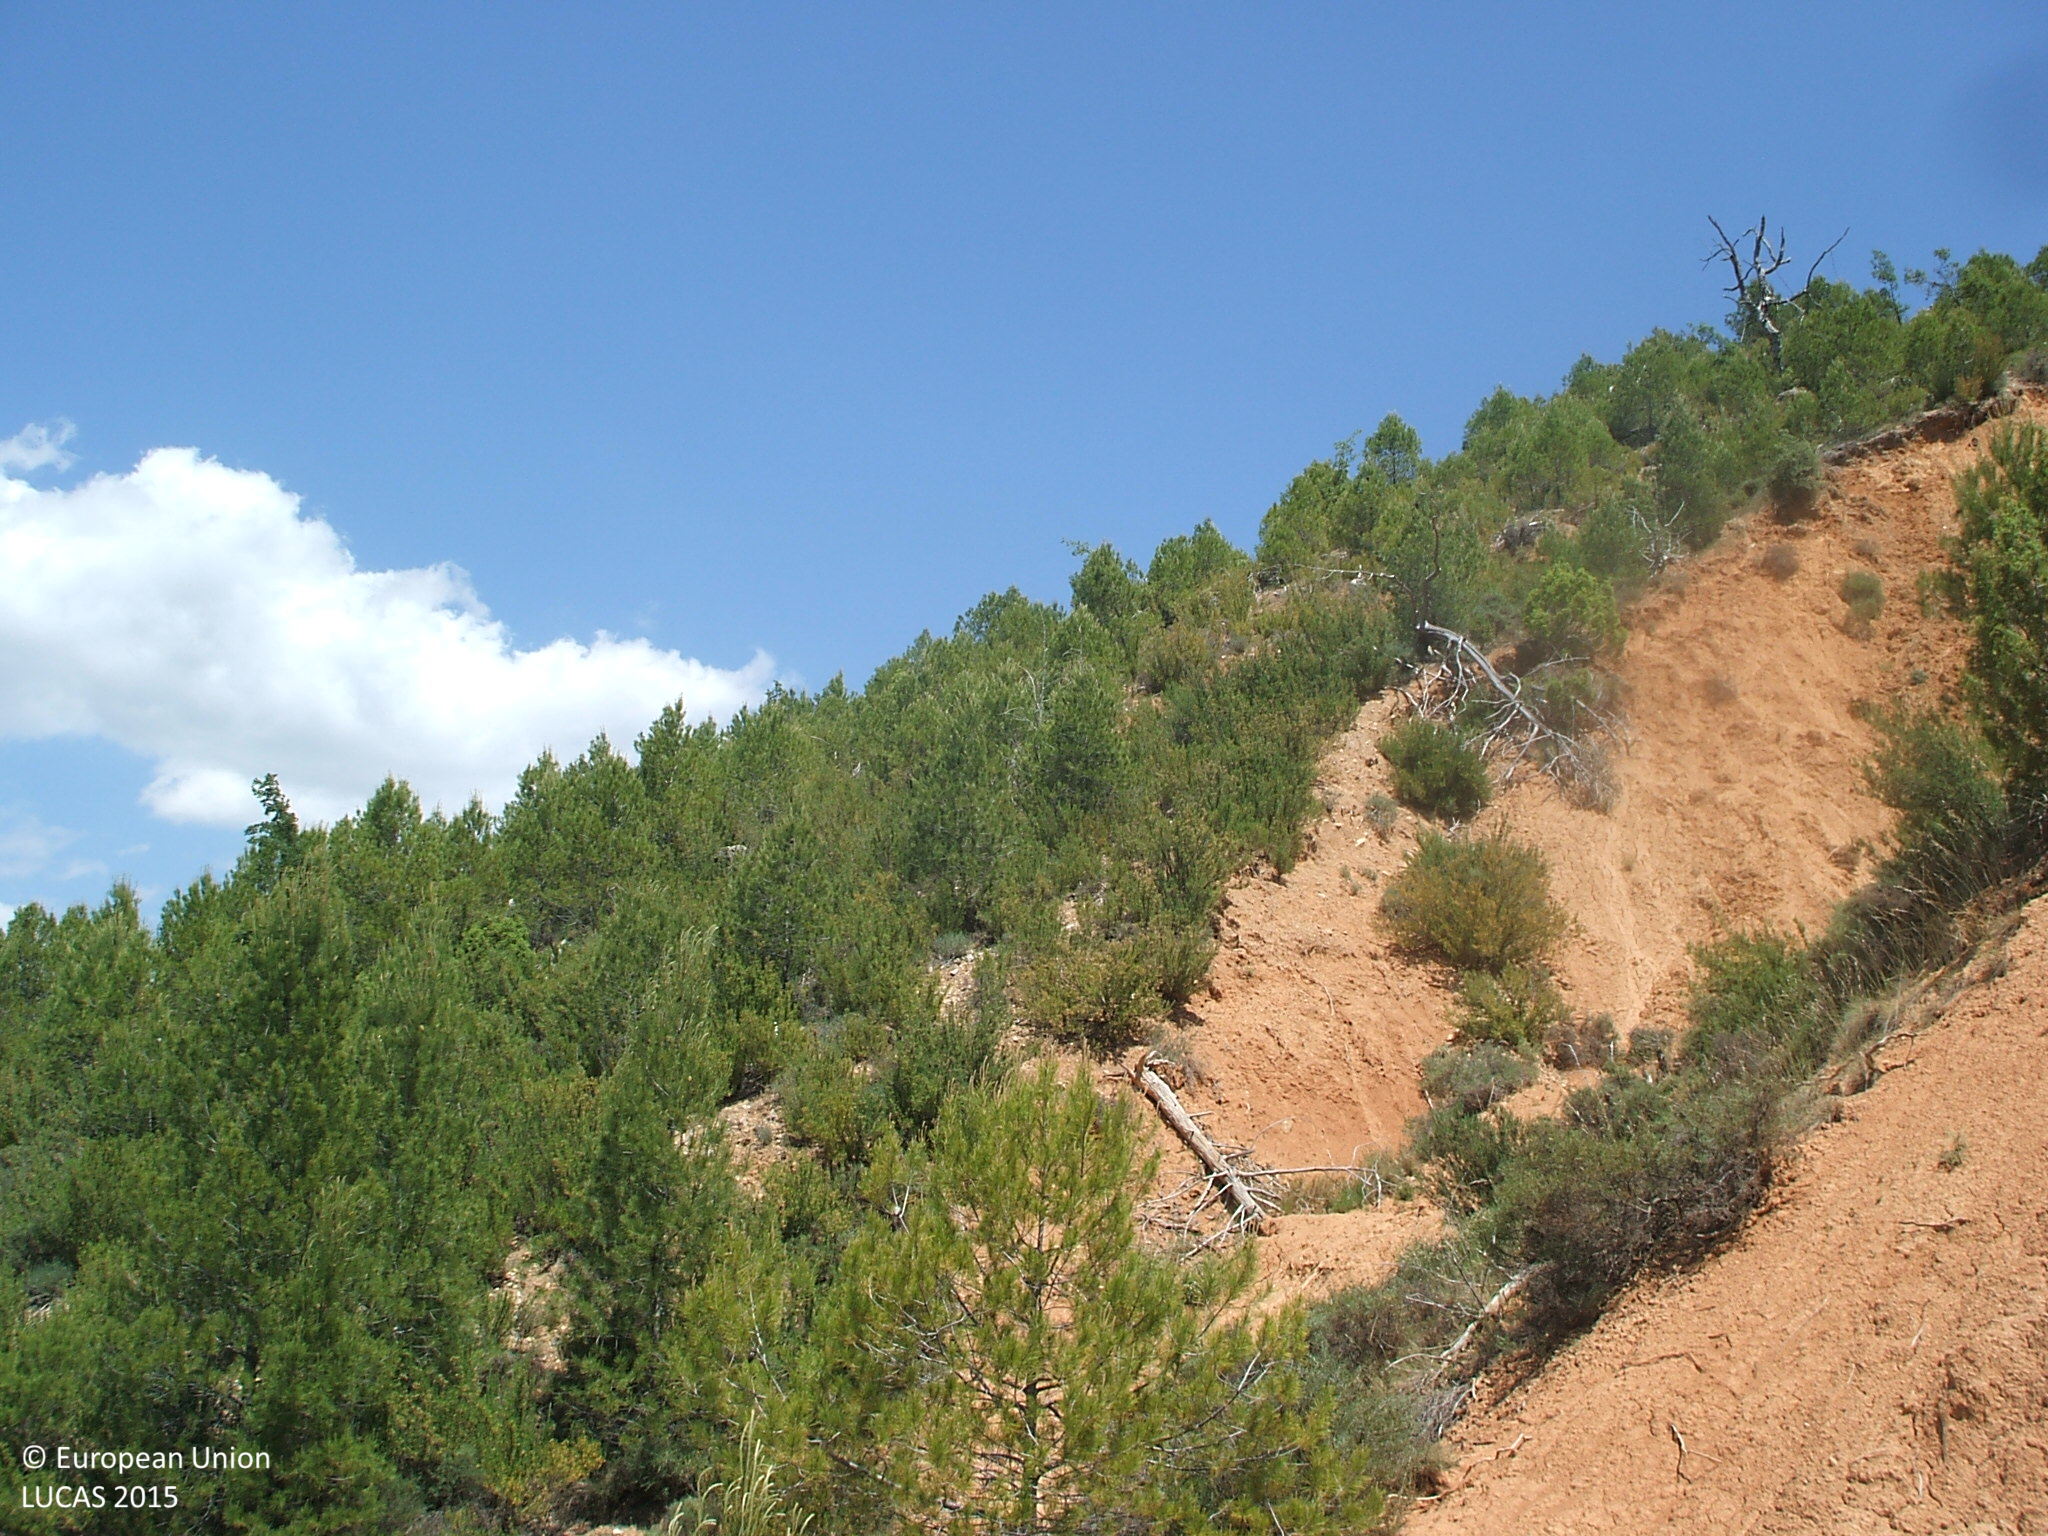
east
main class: Woodland
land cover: Pine dominated coniferous woodland
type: coniferous forest of the mediterranean region
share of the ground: 25 - 50 %
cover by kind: shrubs 50 %, coniferous forest trees 40 %, consolidated bare surface 10 %
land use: Semi-natural and natural areas not in use
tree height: > 5 m
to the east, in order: Pine dominated coniferous woodland; Other bare soil; Pine dominated coniferous woodland; Shrubland with sparse tree cover; Pine dominated coniferous woodland
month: May
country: ES
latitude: 40.7049
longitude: -0.1517
